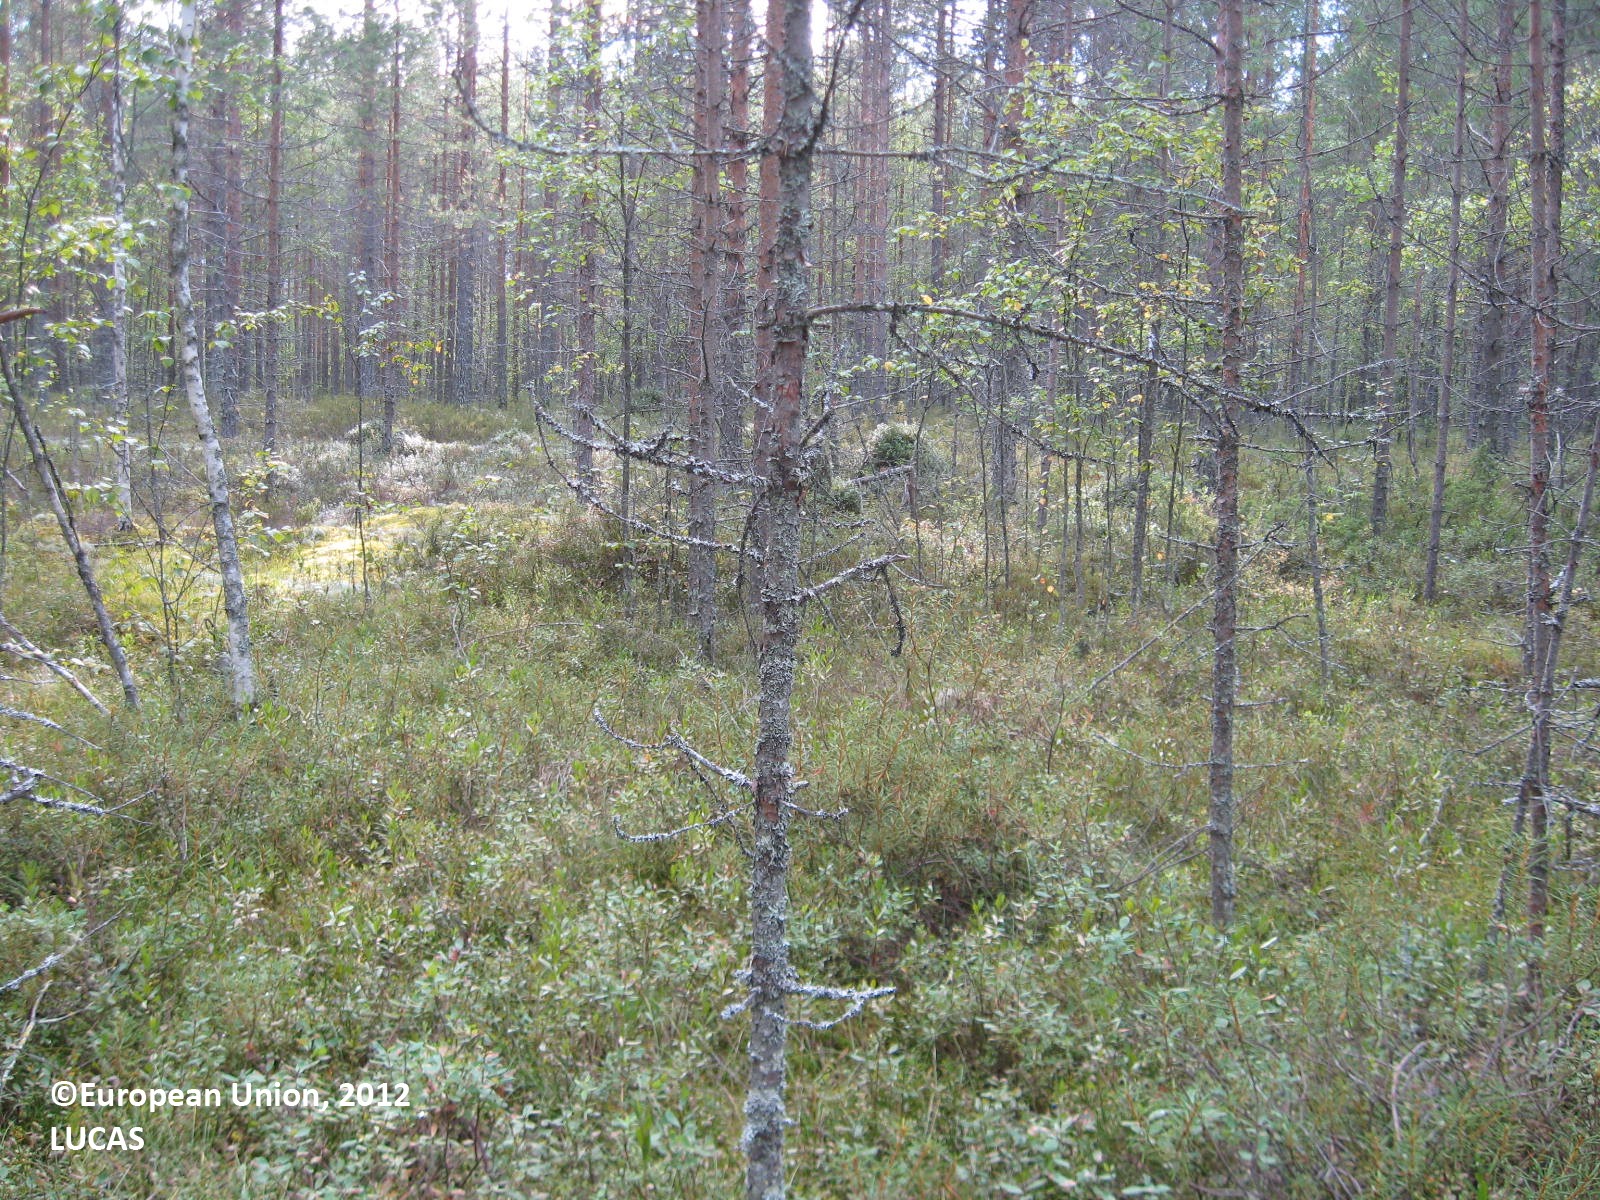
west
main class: Woodland
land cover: Pine dominated coniferous woodland
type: boreal forest
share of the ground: > 75 %
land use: Forestry
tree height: > 5 m
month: August
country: FI
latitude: 63.4198
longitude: 30.1468
